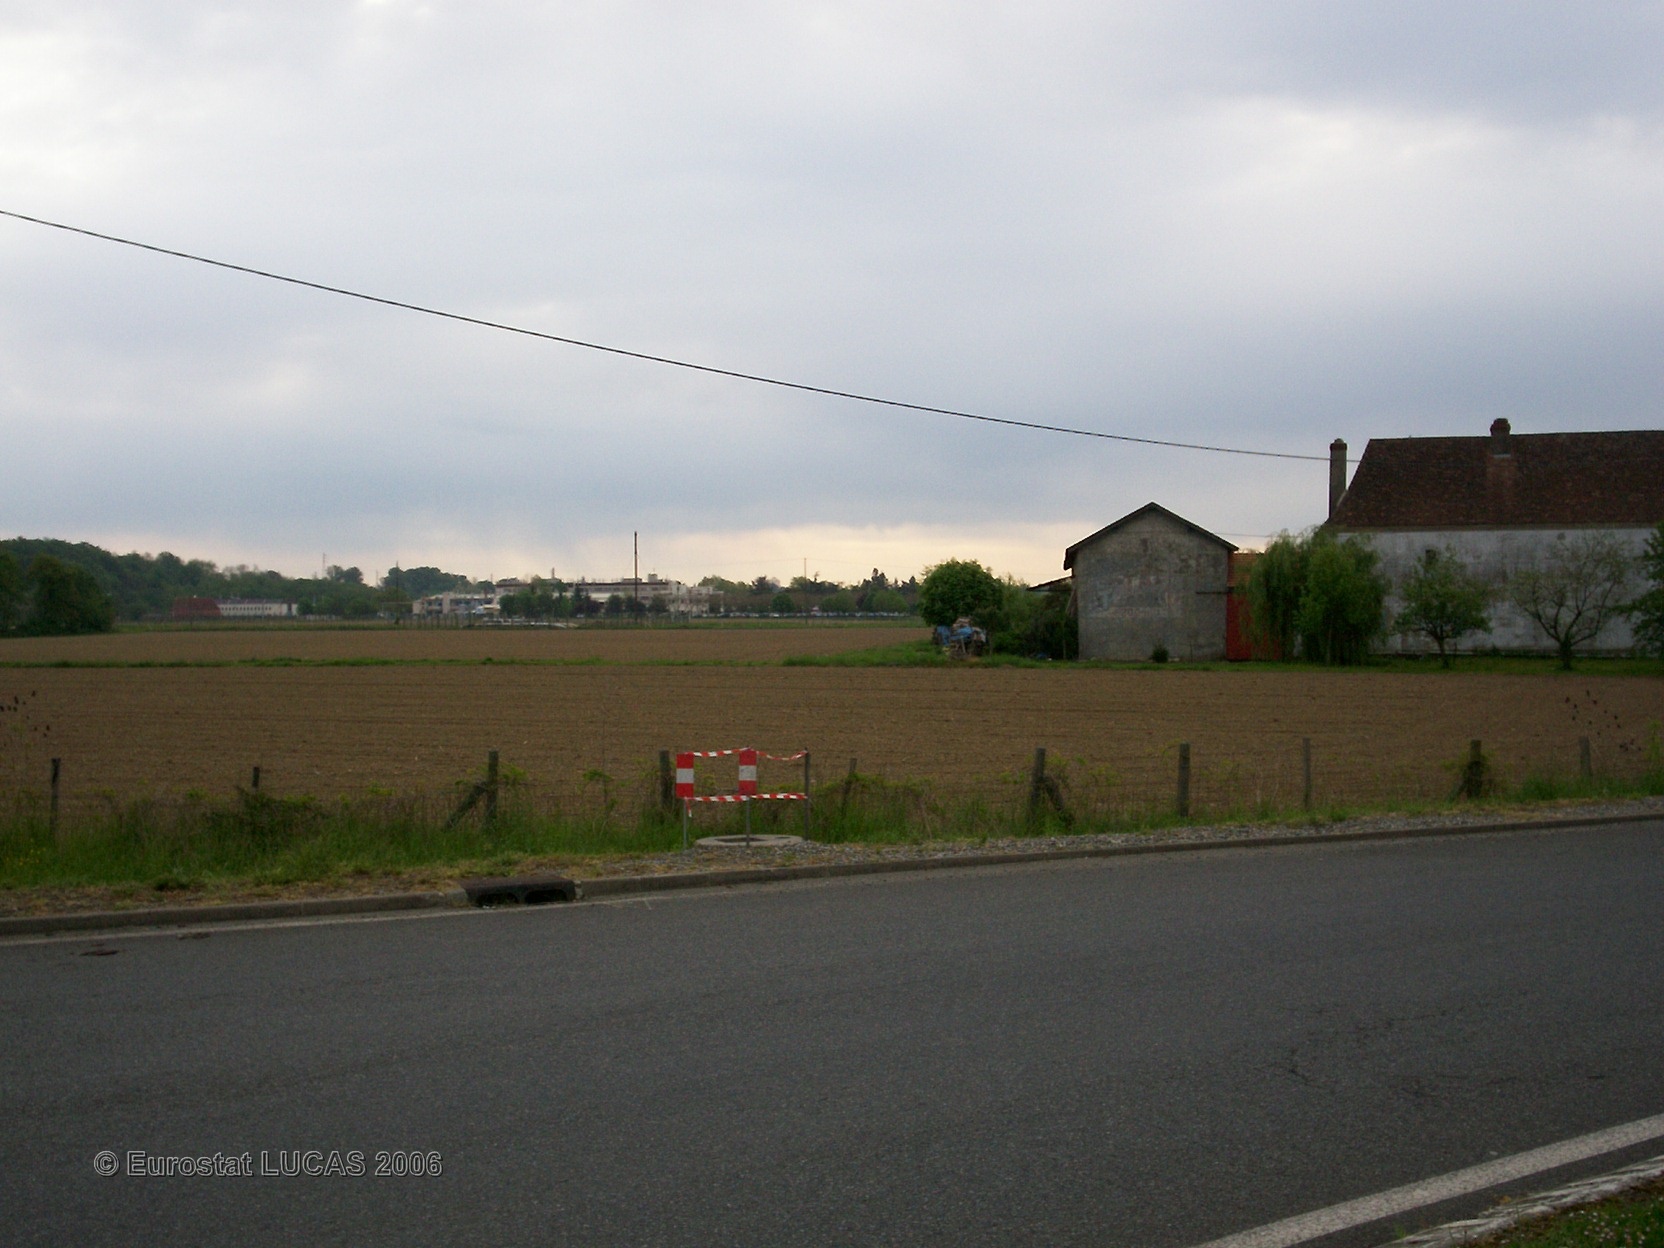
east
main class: Grassland
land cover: Grassland with sparse tree/shrub cover
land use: Road transport
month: April
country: FR
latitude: 43.4197
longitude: -0.6442
